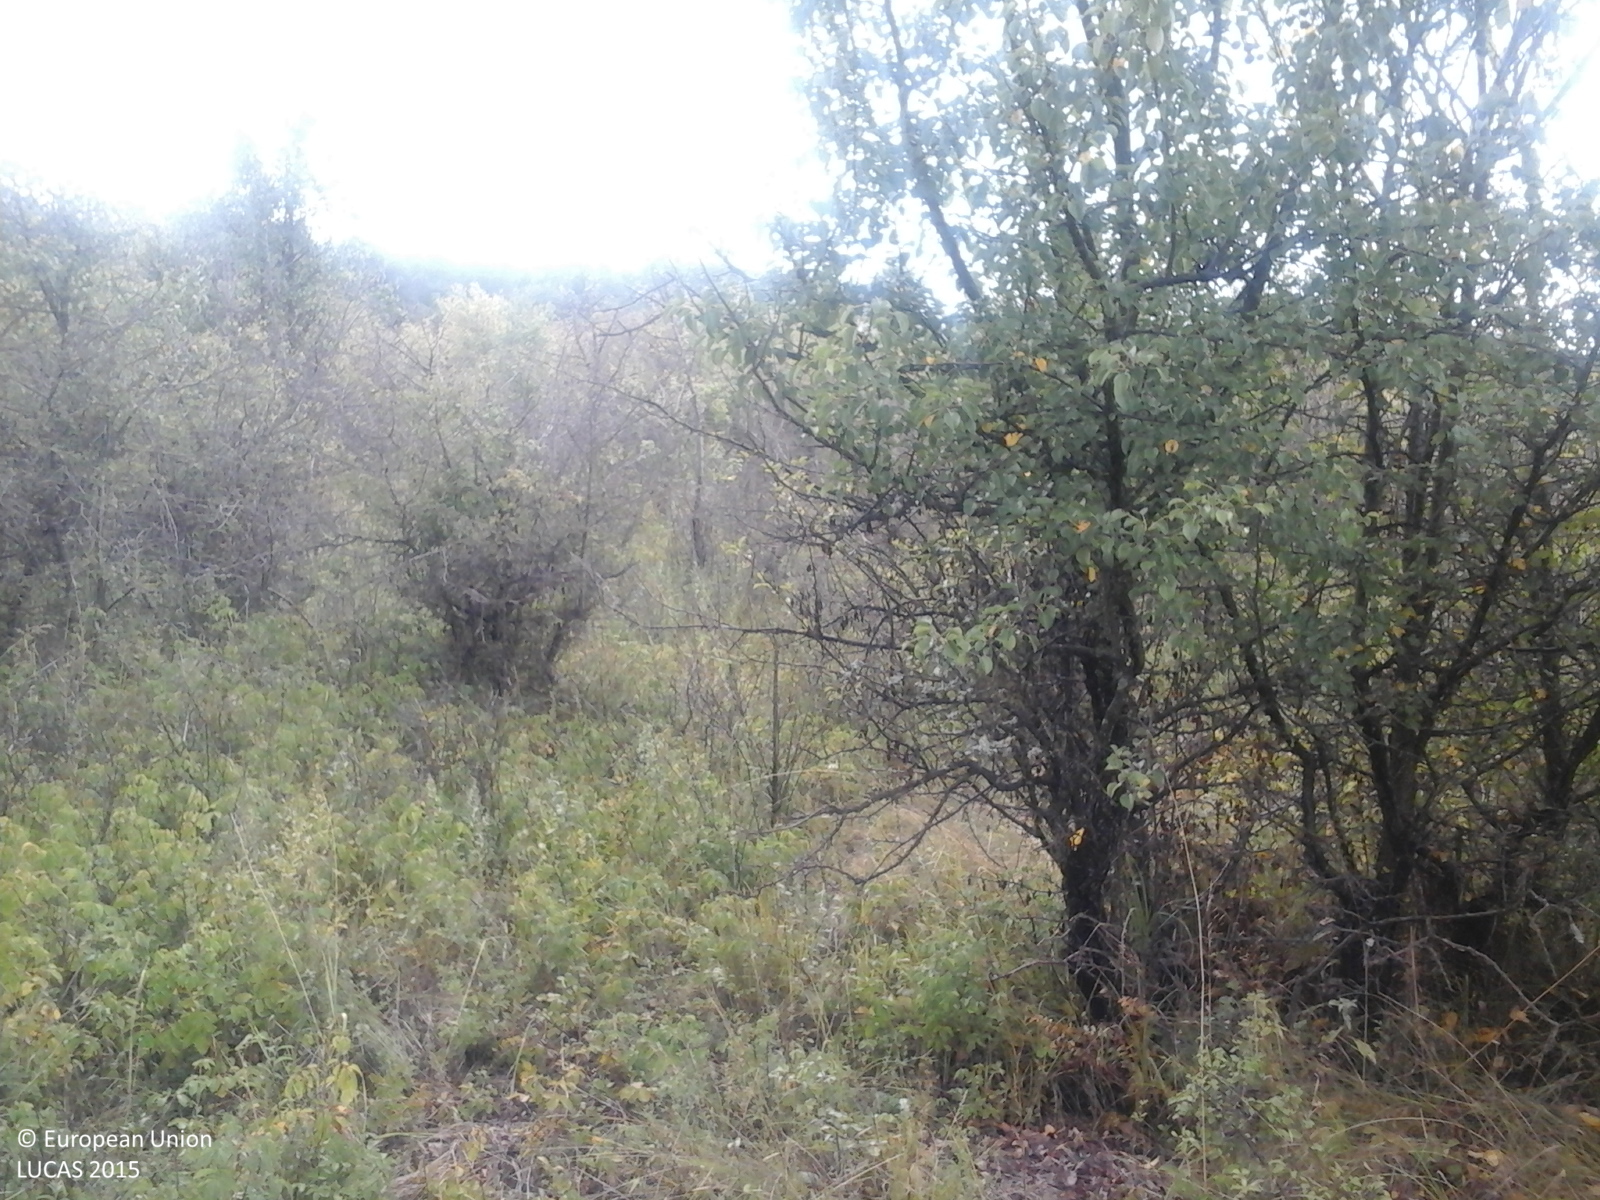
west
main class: Shrubland
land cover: Shrubland with sparse tree cover
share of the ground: 25 - 50 %
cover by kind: herbaceous plants 60 %, shrubs 35 %, broadleaved forest trees 5 %
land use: Abandoned areas
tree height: < 5 m
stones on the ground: < 10 %
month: August
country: RO
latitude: 45.8971
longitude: 21.6229
